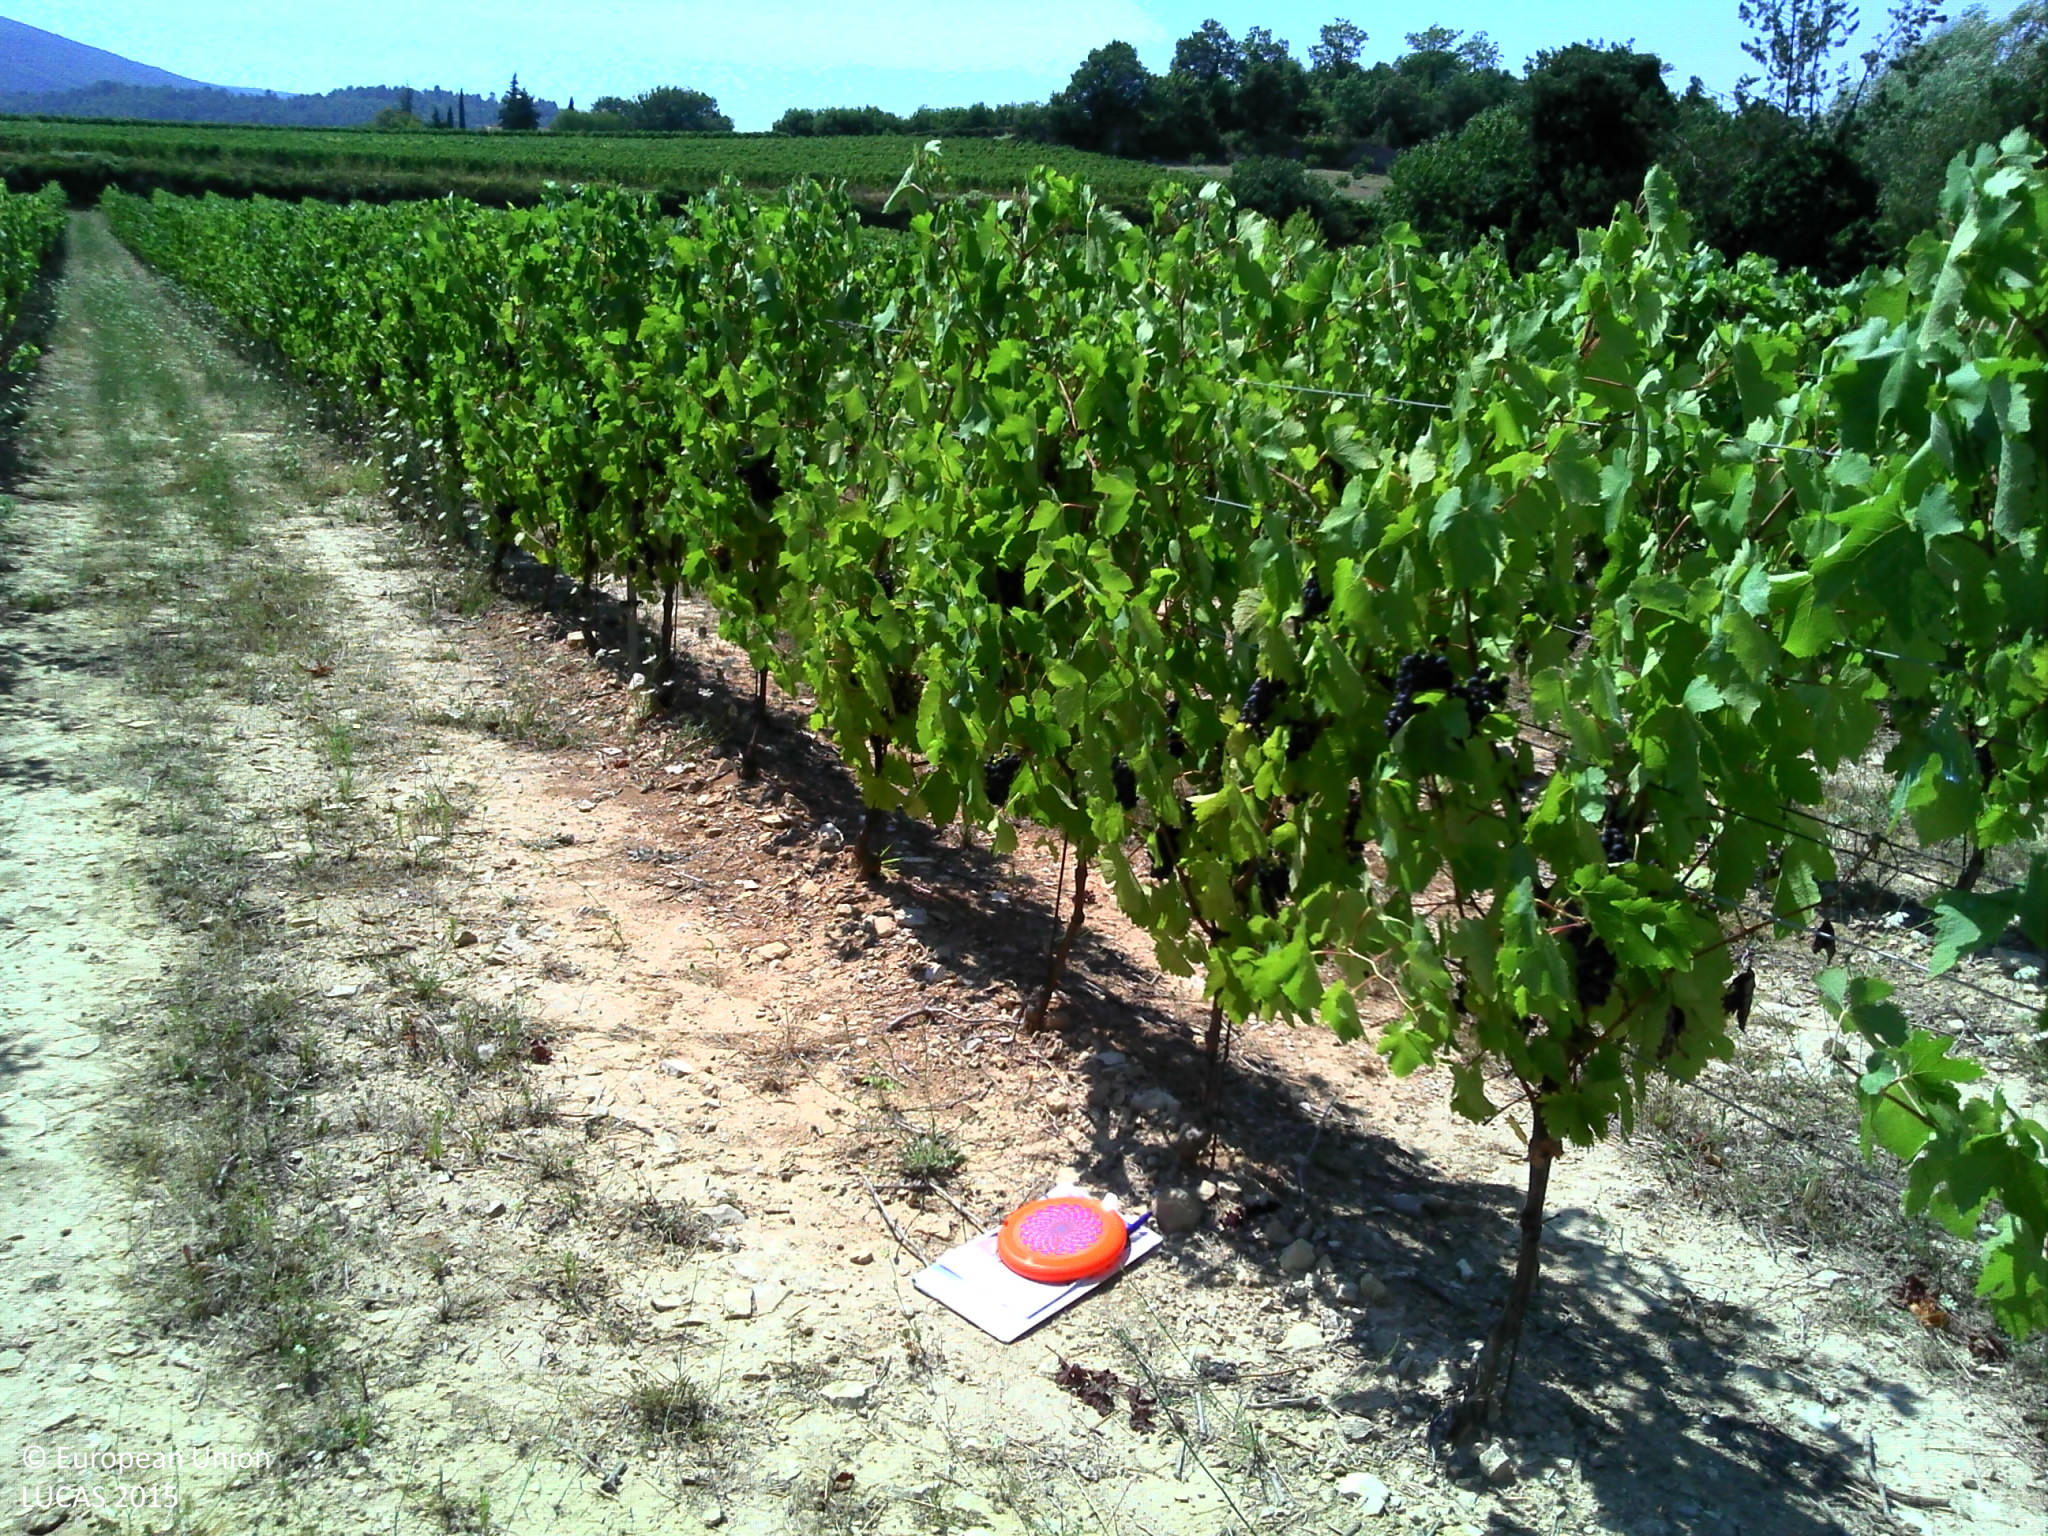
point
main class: Cropland
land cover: Vineyards
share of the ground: 25 - 50 %
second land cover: Other bare soil
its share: > 75 %
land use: Agriculture (excluding fallow land and kitchen gardens)
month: August
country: FR
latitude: 43.8284
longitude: 5.2960
